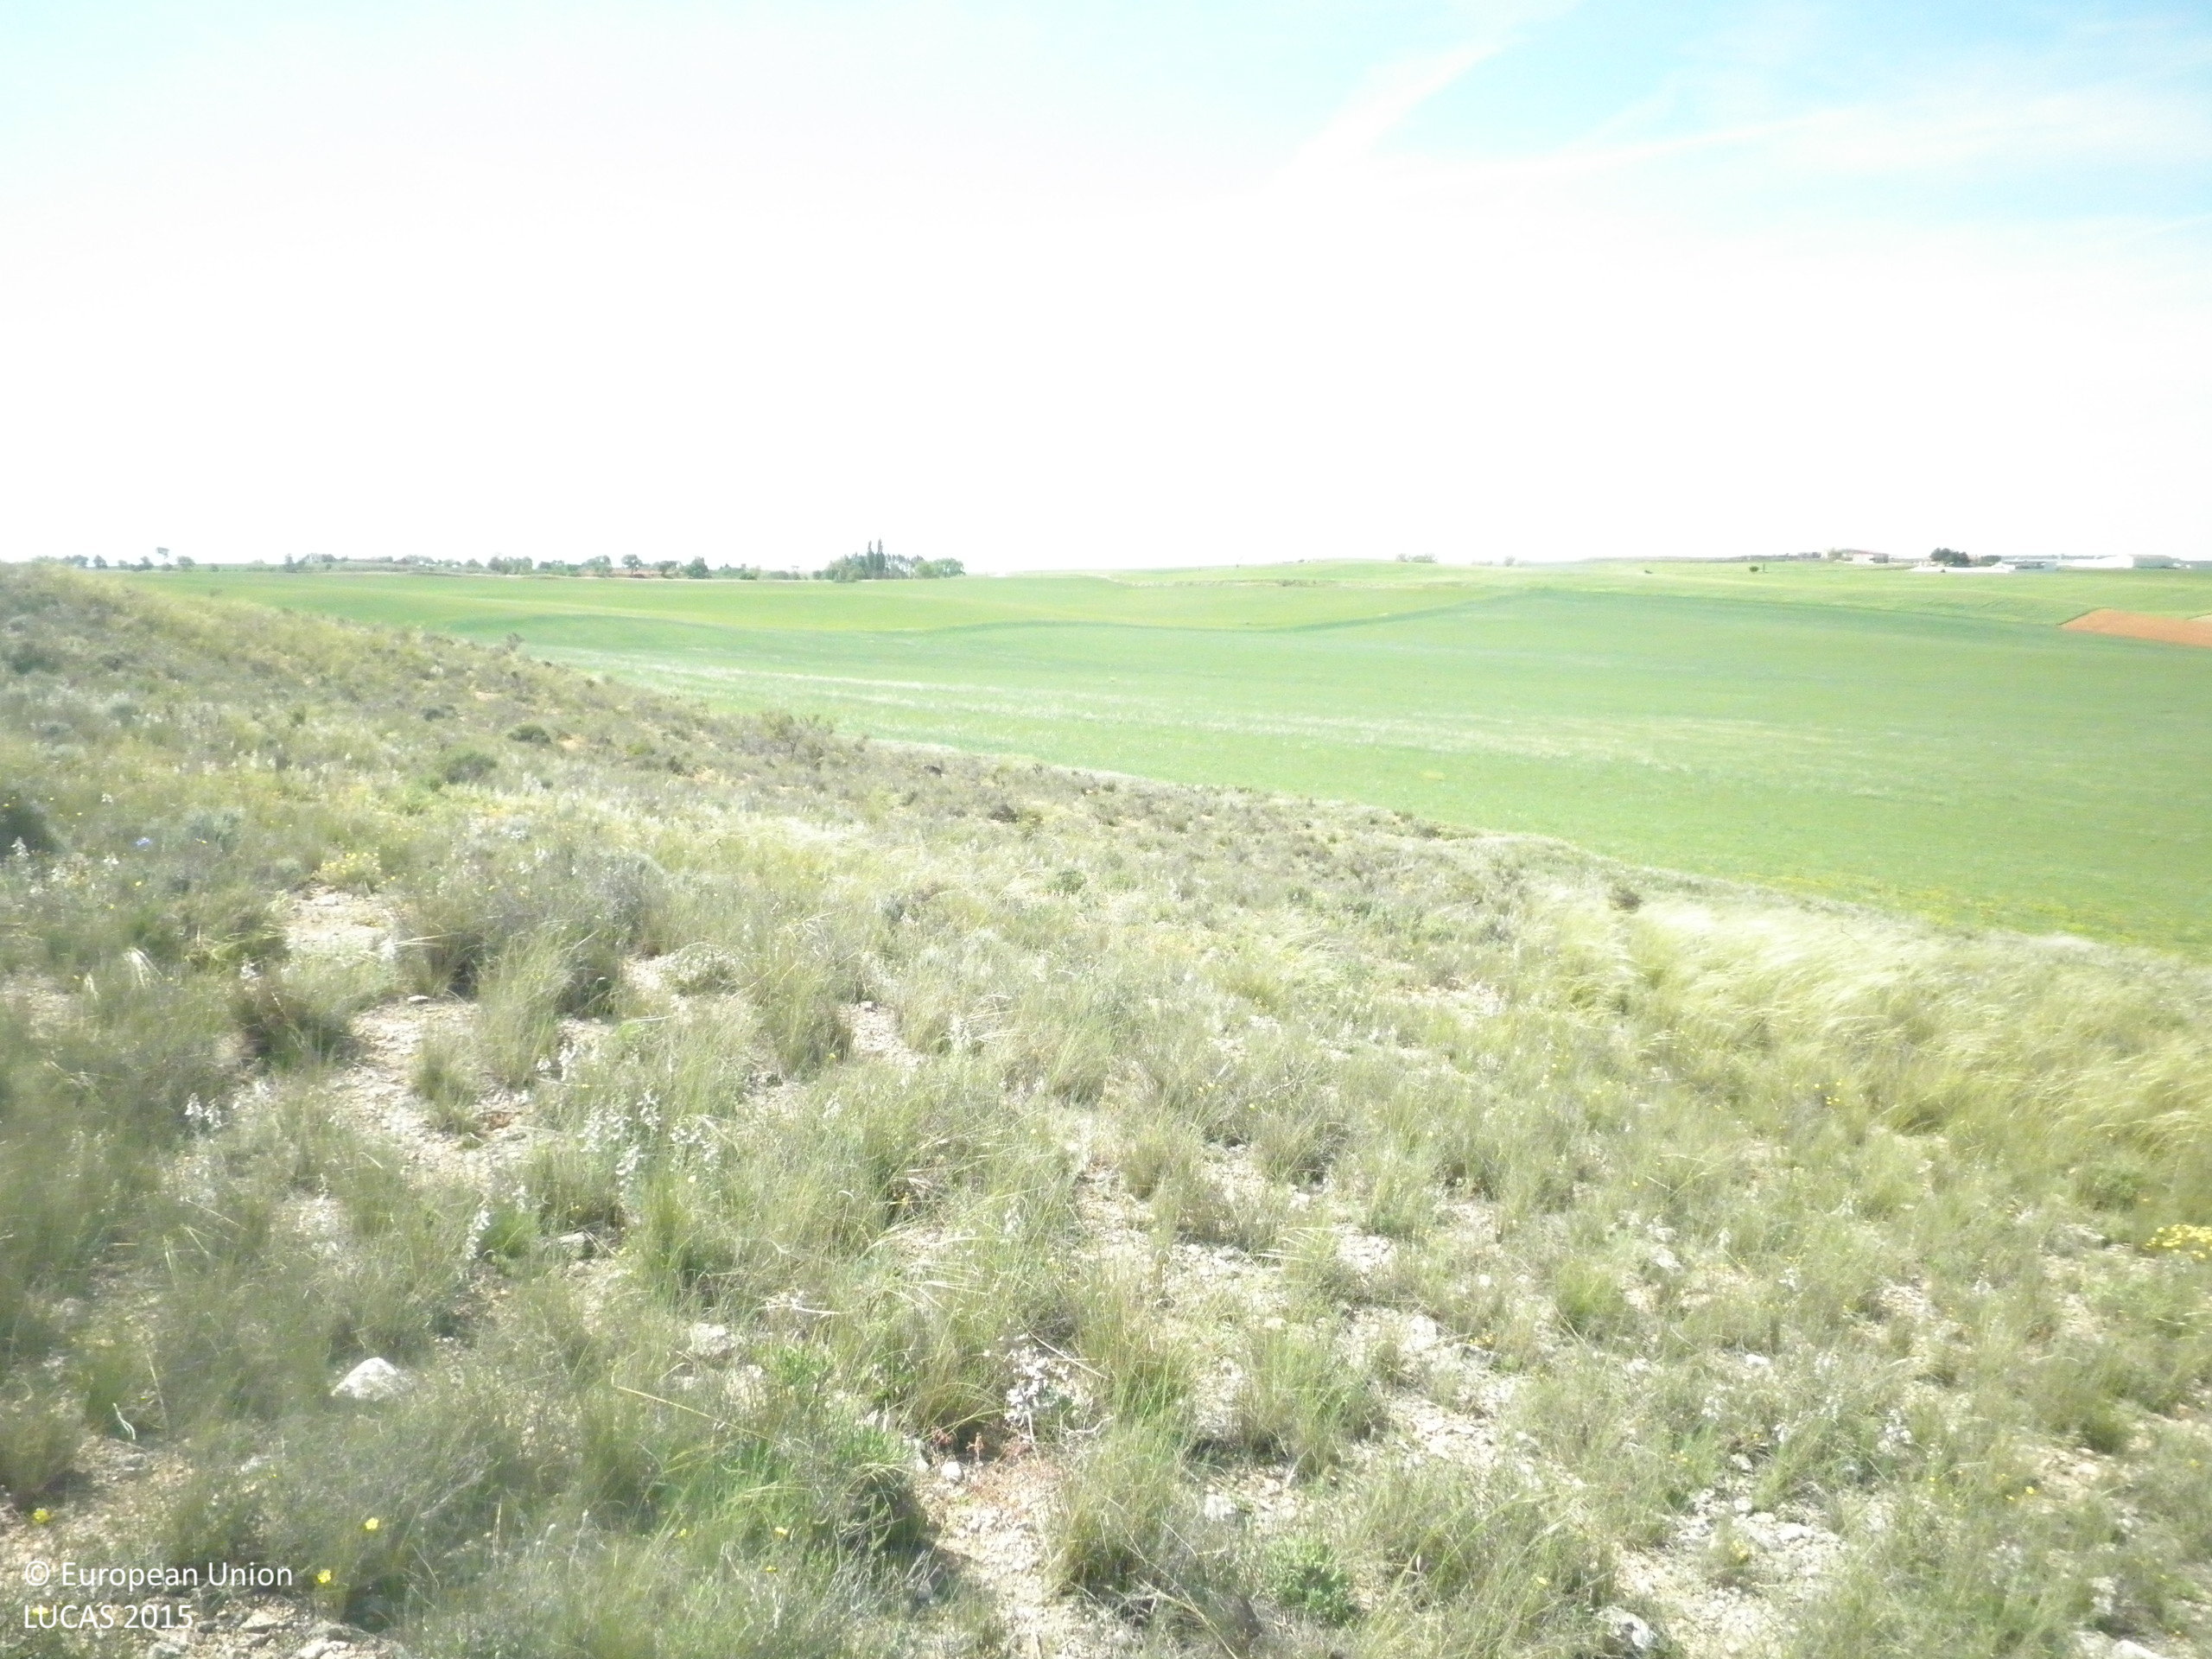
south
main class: Shrubland
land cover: Shrubland without tree cover
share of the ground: > 75 %
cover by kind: unconsolidated bare surface 50 %, herbaceous plants 25 %, shrubs 15 %, consolidated bare surface 10 %
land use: Semi-natural and natural areas not in use
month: May
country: ES
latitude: 39.7072
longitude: -2.7421
